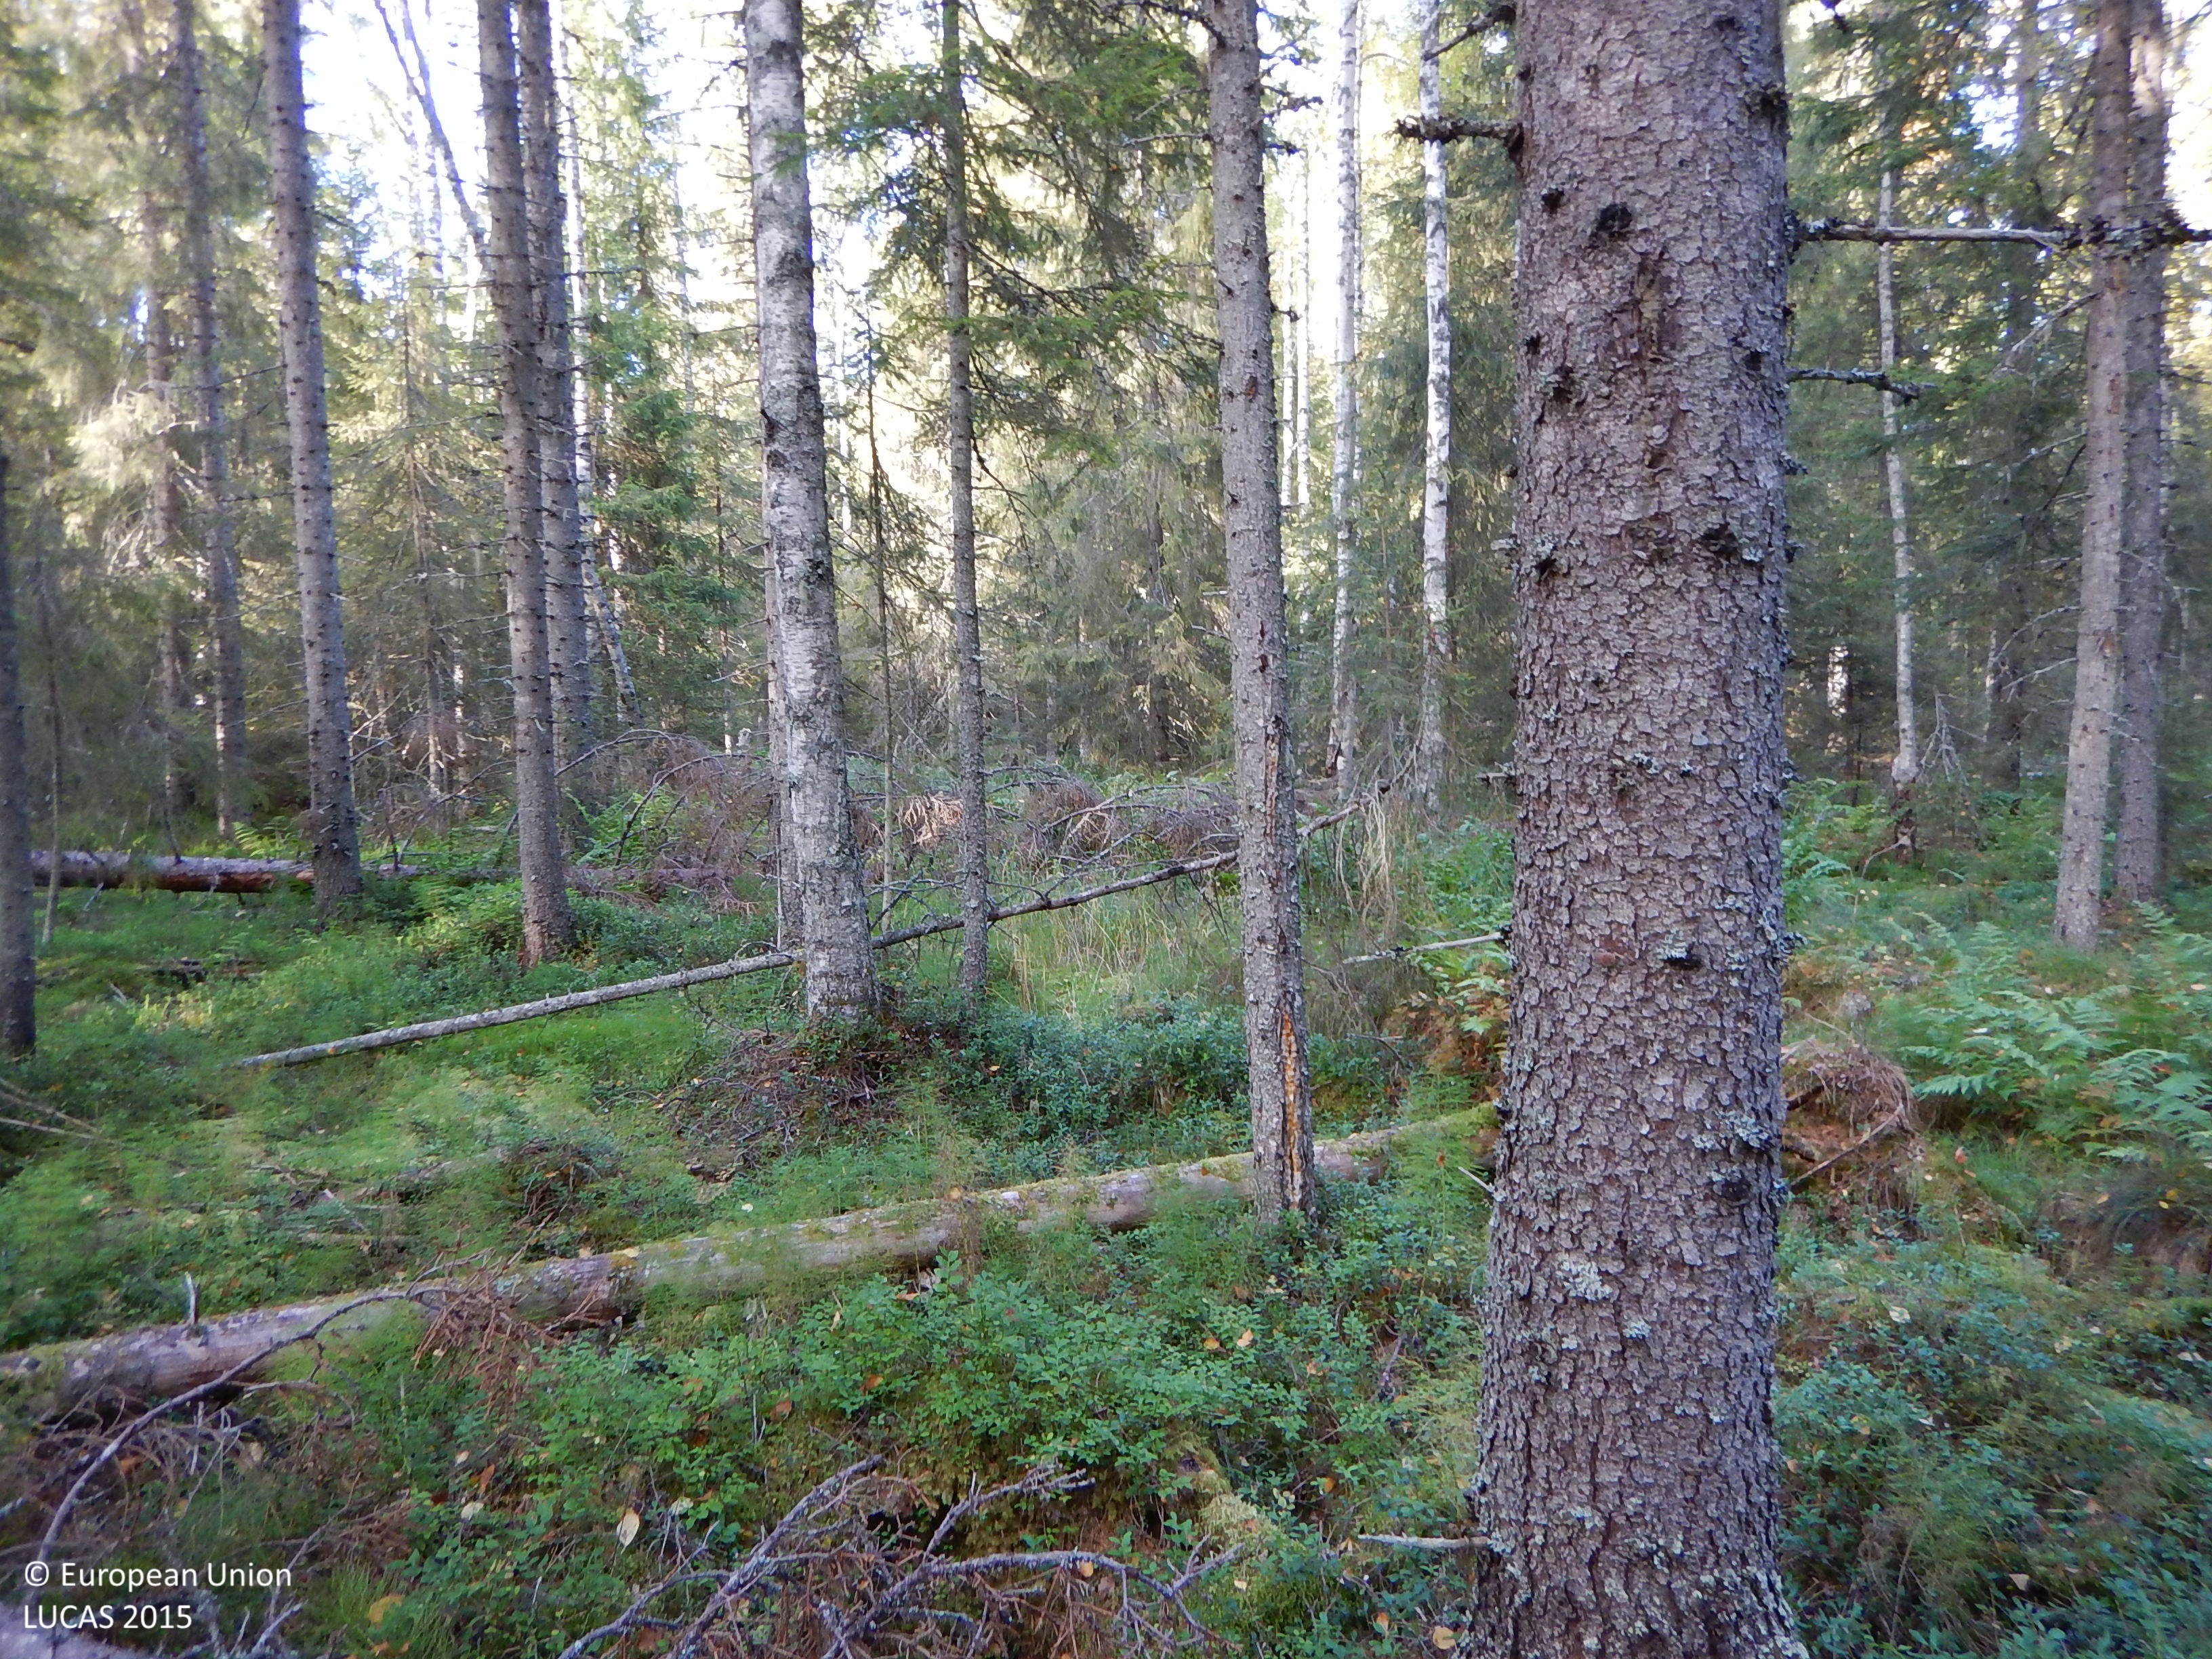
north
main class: Woodland
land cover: Spruce dominated coniferous woodland
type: boreal forest
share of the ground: 50 - 75 %
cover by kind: coniferous forest trees 50 %, shrubs 15 %, lichens and mosses 15 %, broadleaved forest trees 10 %, herbaceous plants 10 %
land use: Forestry
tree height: > 5 m
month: September
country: SE
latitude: 64.6955
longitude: 20.1005
